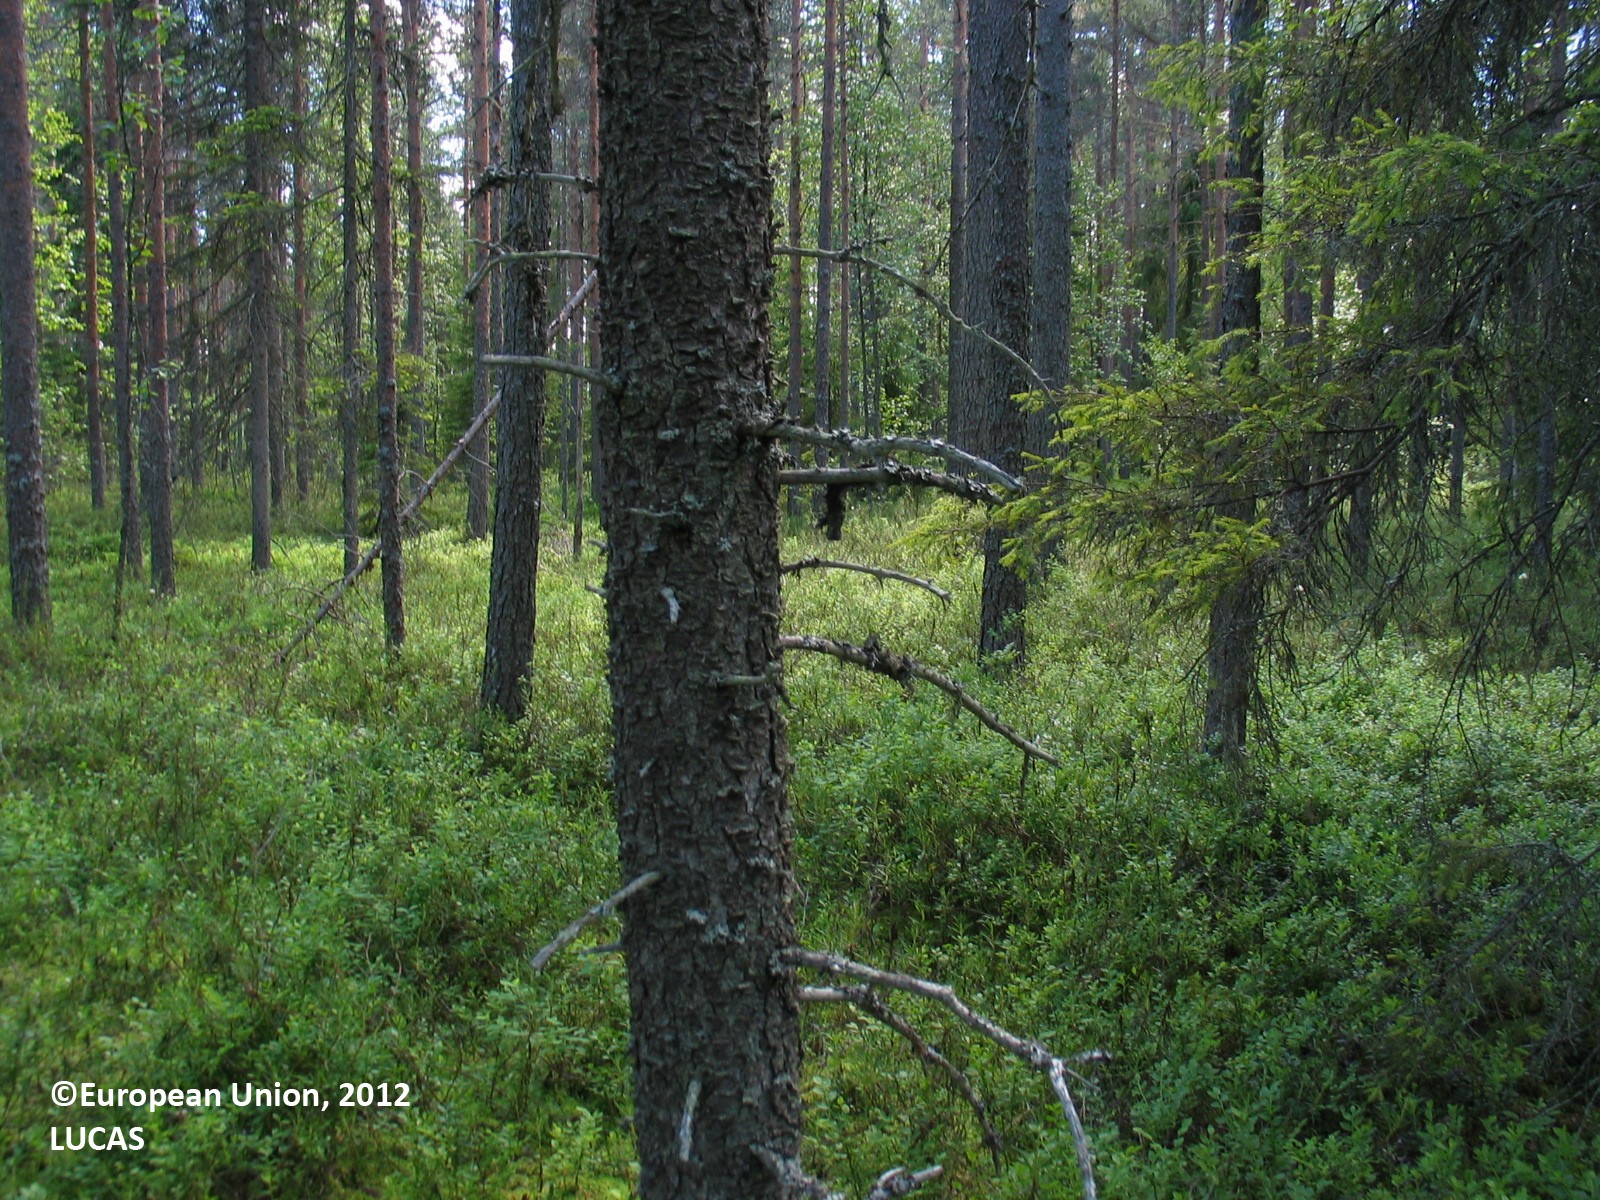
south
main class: Woodland
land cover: Pine dominated coniferous woodland
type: mire and swamp forests
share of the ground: 50 - 75 %
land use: Forestry
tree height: > 5 m
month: July
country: FI
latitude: 64.7082
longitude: 26.5388
